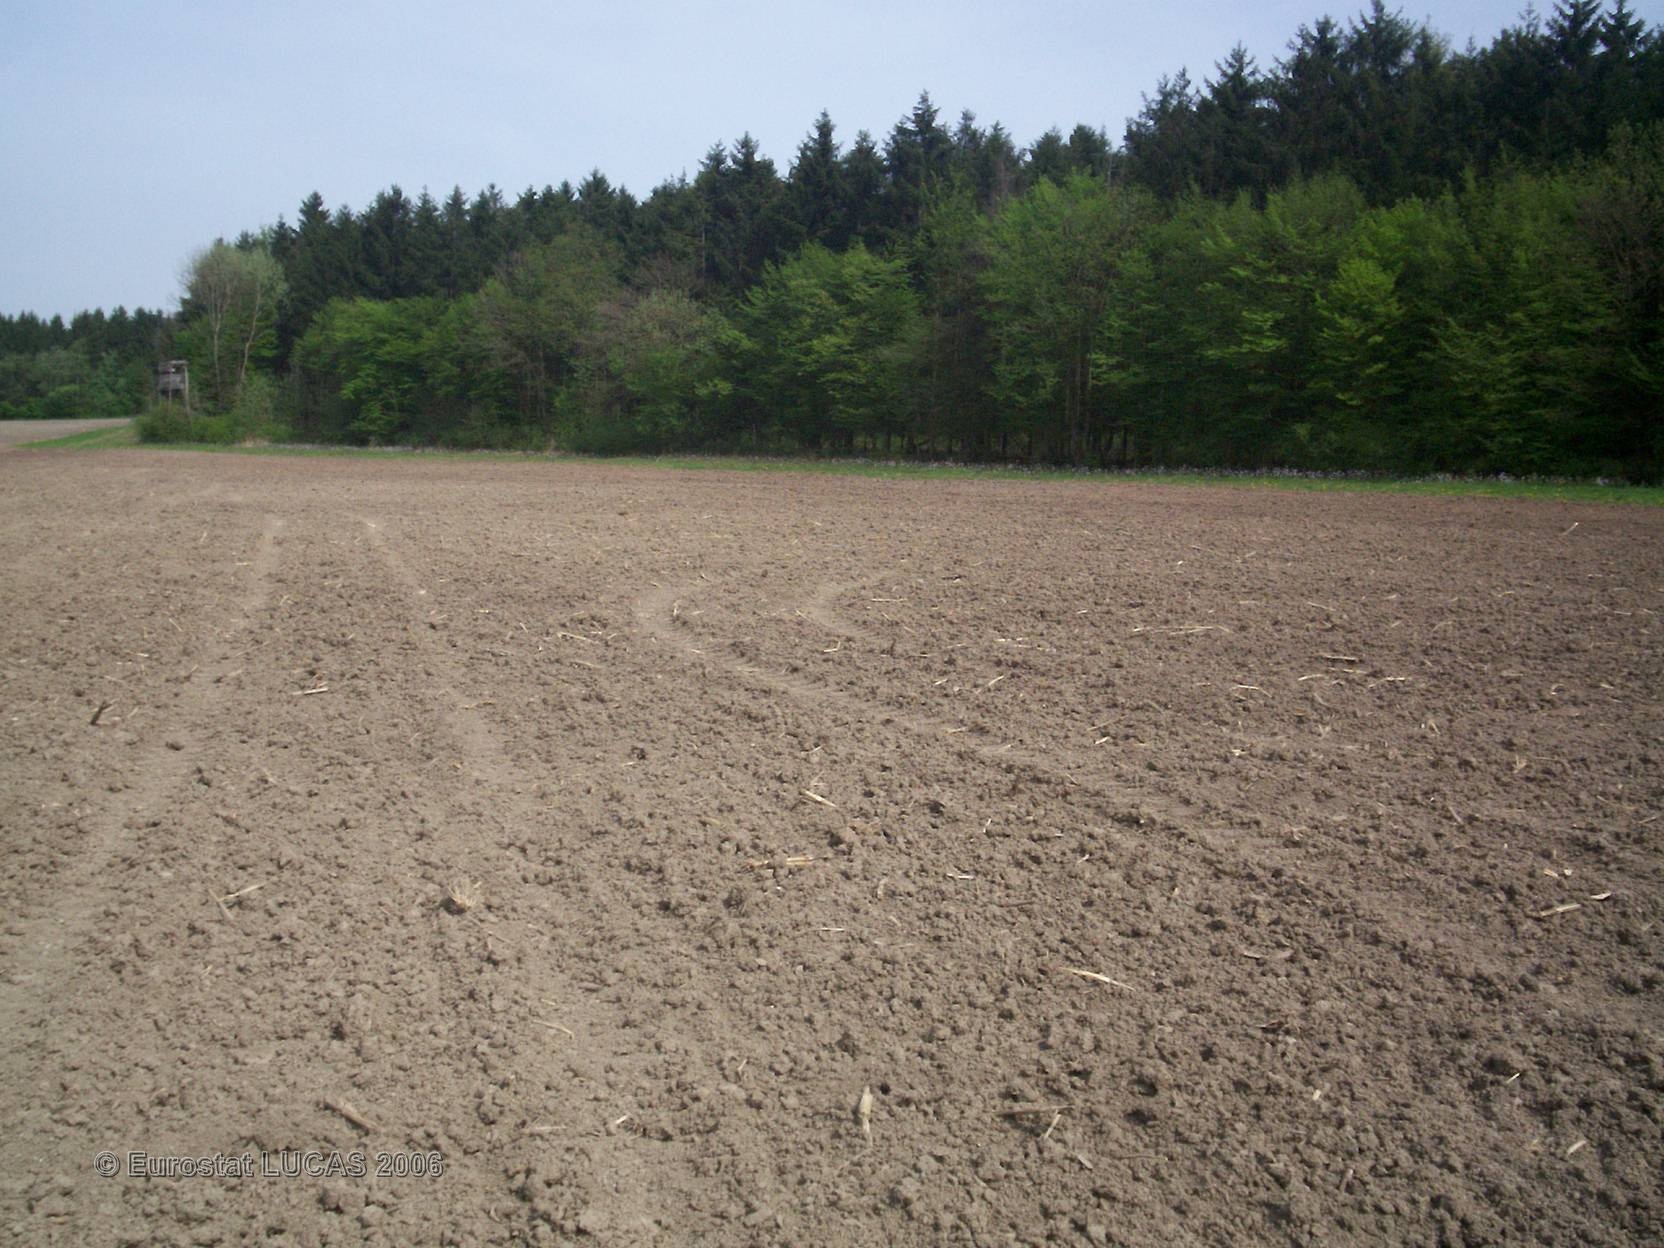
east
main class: Cropland
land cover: Maize
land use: Agriculture (excluding fallow land and kitchen gardens)
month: May
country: FR
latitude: 49.3391
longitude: 6.5180
